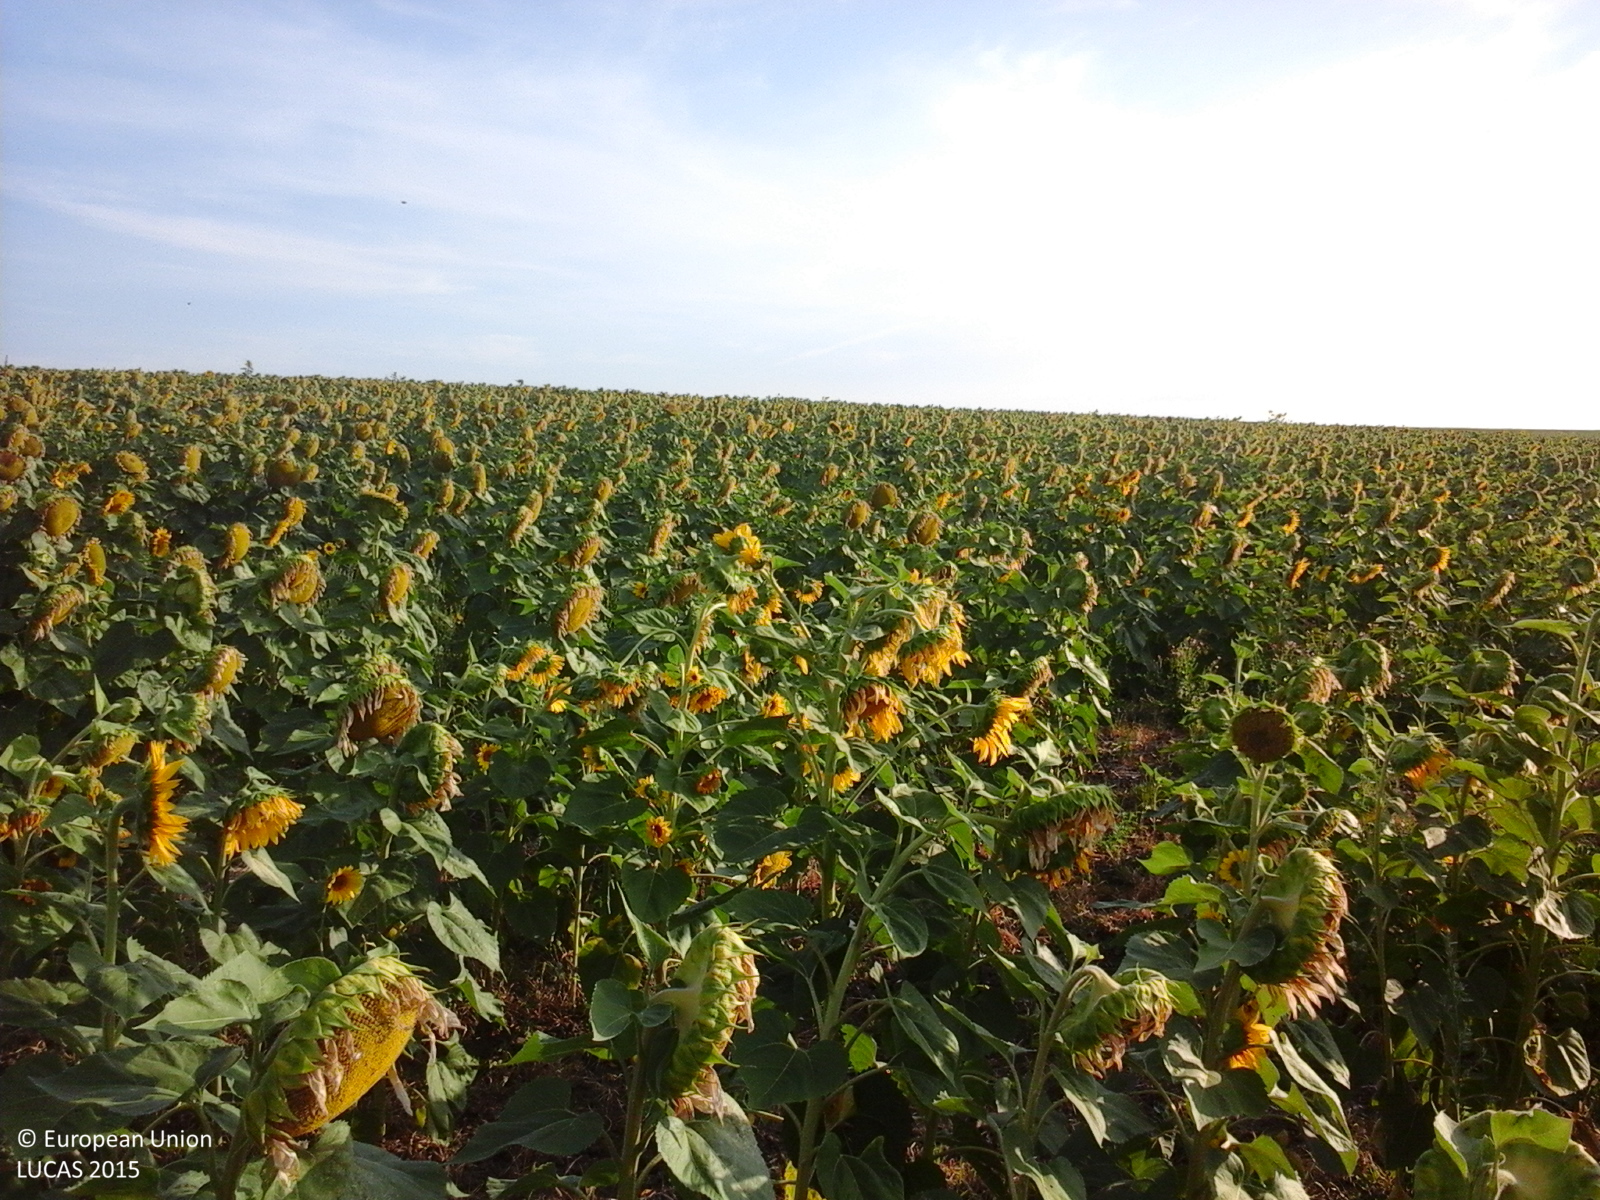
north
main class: Cropland
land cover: Sunflower
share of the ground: > 75 %
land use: Agriculture (excluding fallow land and kitchen gardens)
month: July
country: RO
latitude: 46.1964
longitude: 28.0736
